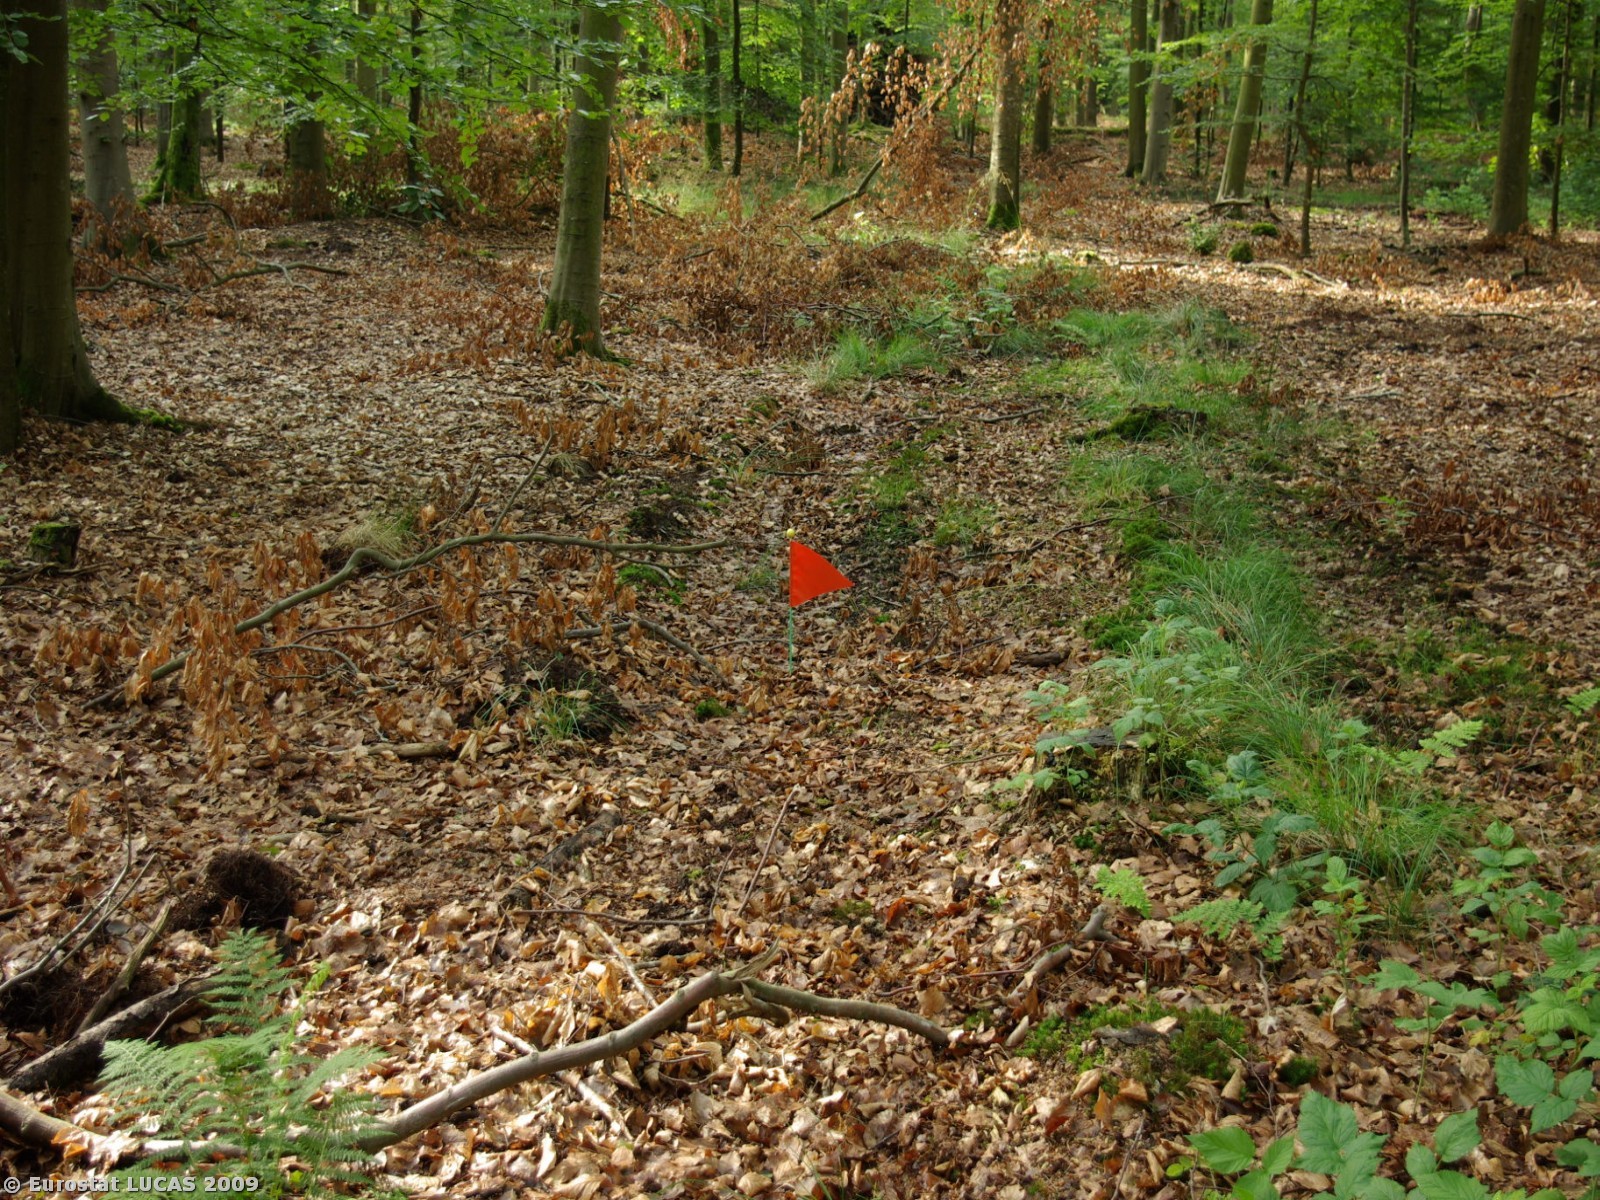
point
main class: Woodland
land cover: Broadleaved woodland
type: beech forest
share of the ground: > 75 %
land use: Forestry
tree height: > 5 m
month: July
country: DK
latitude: 54.9600
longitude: 8.8296
